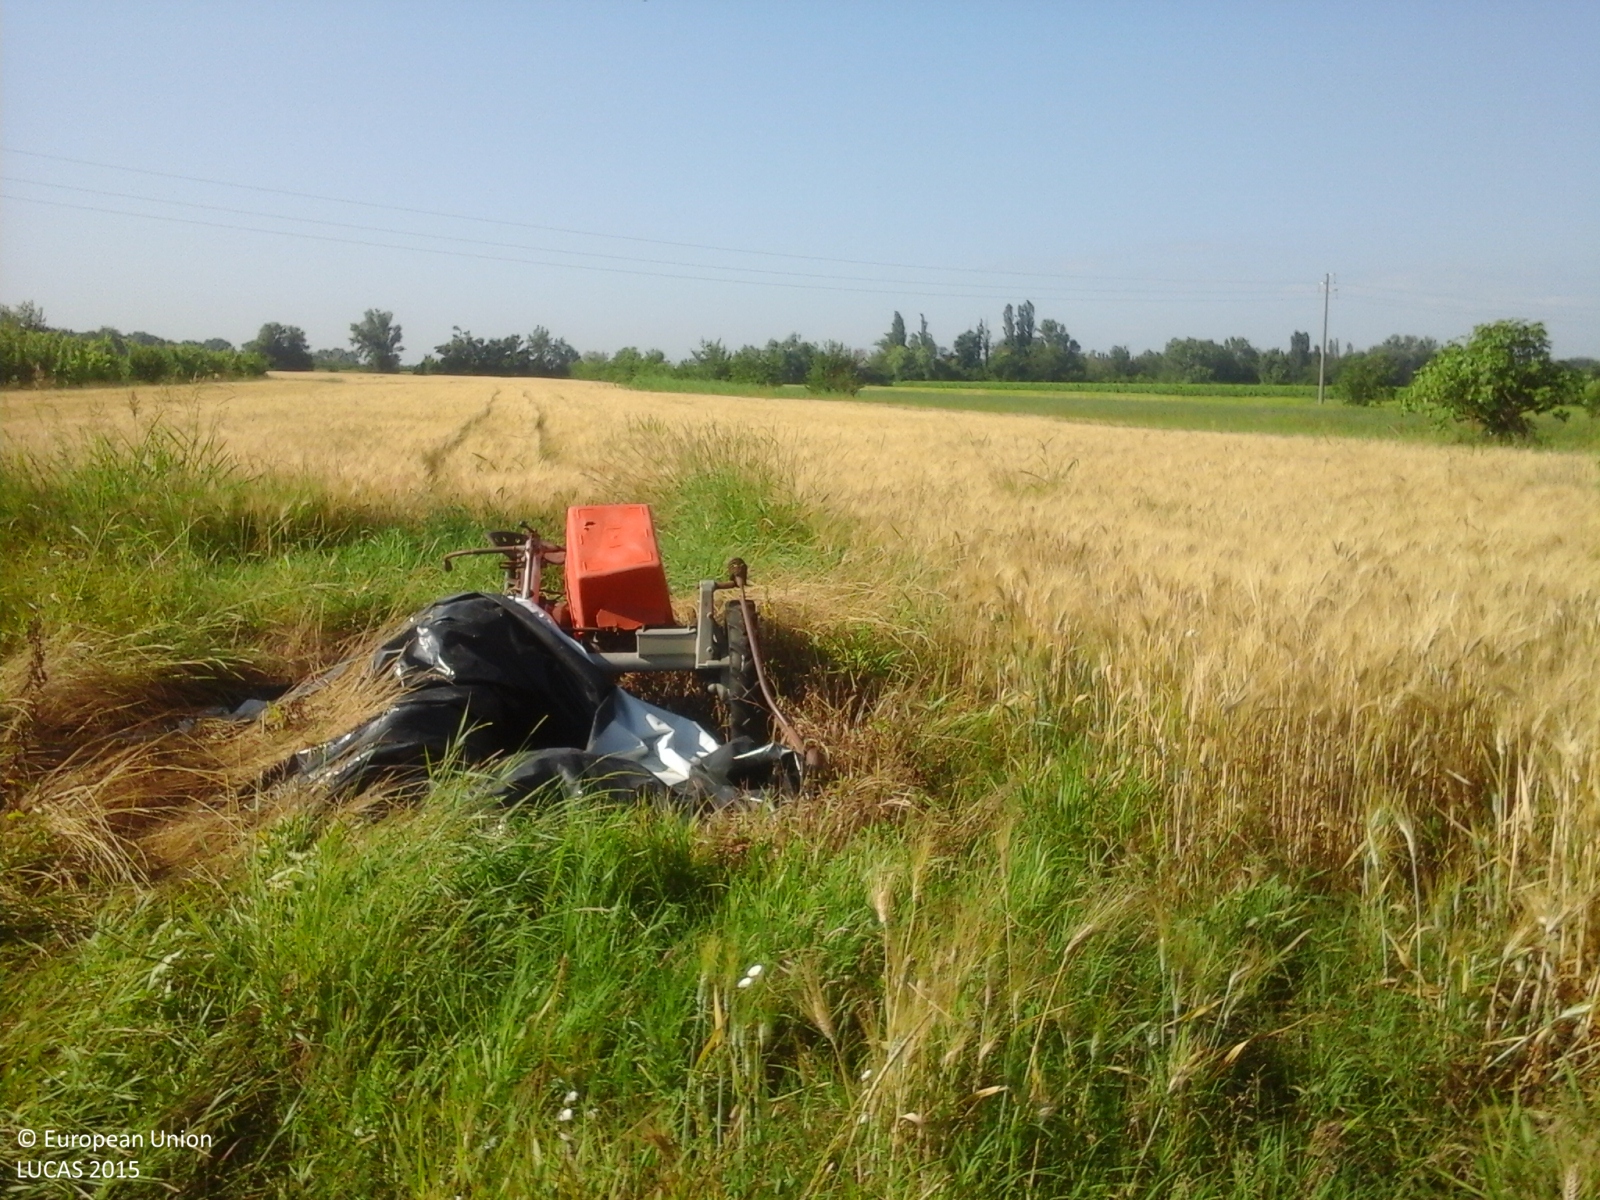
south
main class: Cropland
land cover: Common wheat
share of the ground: > 75 %
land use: Agriculture (excluding fallow land and kitchen gardens)
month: June
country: IT
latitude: 44.8875
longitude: 10.9224
